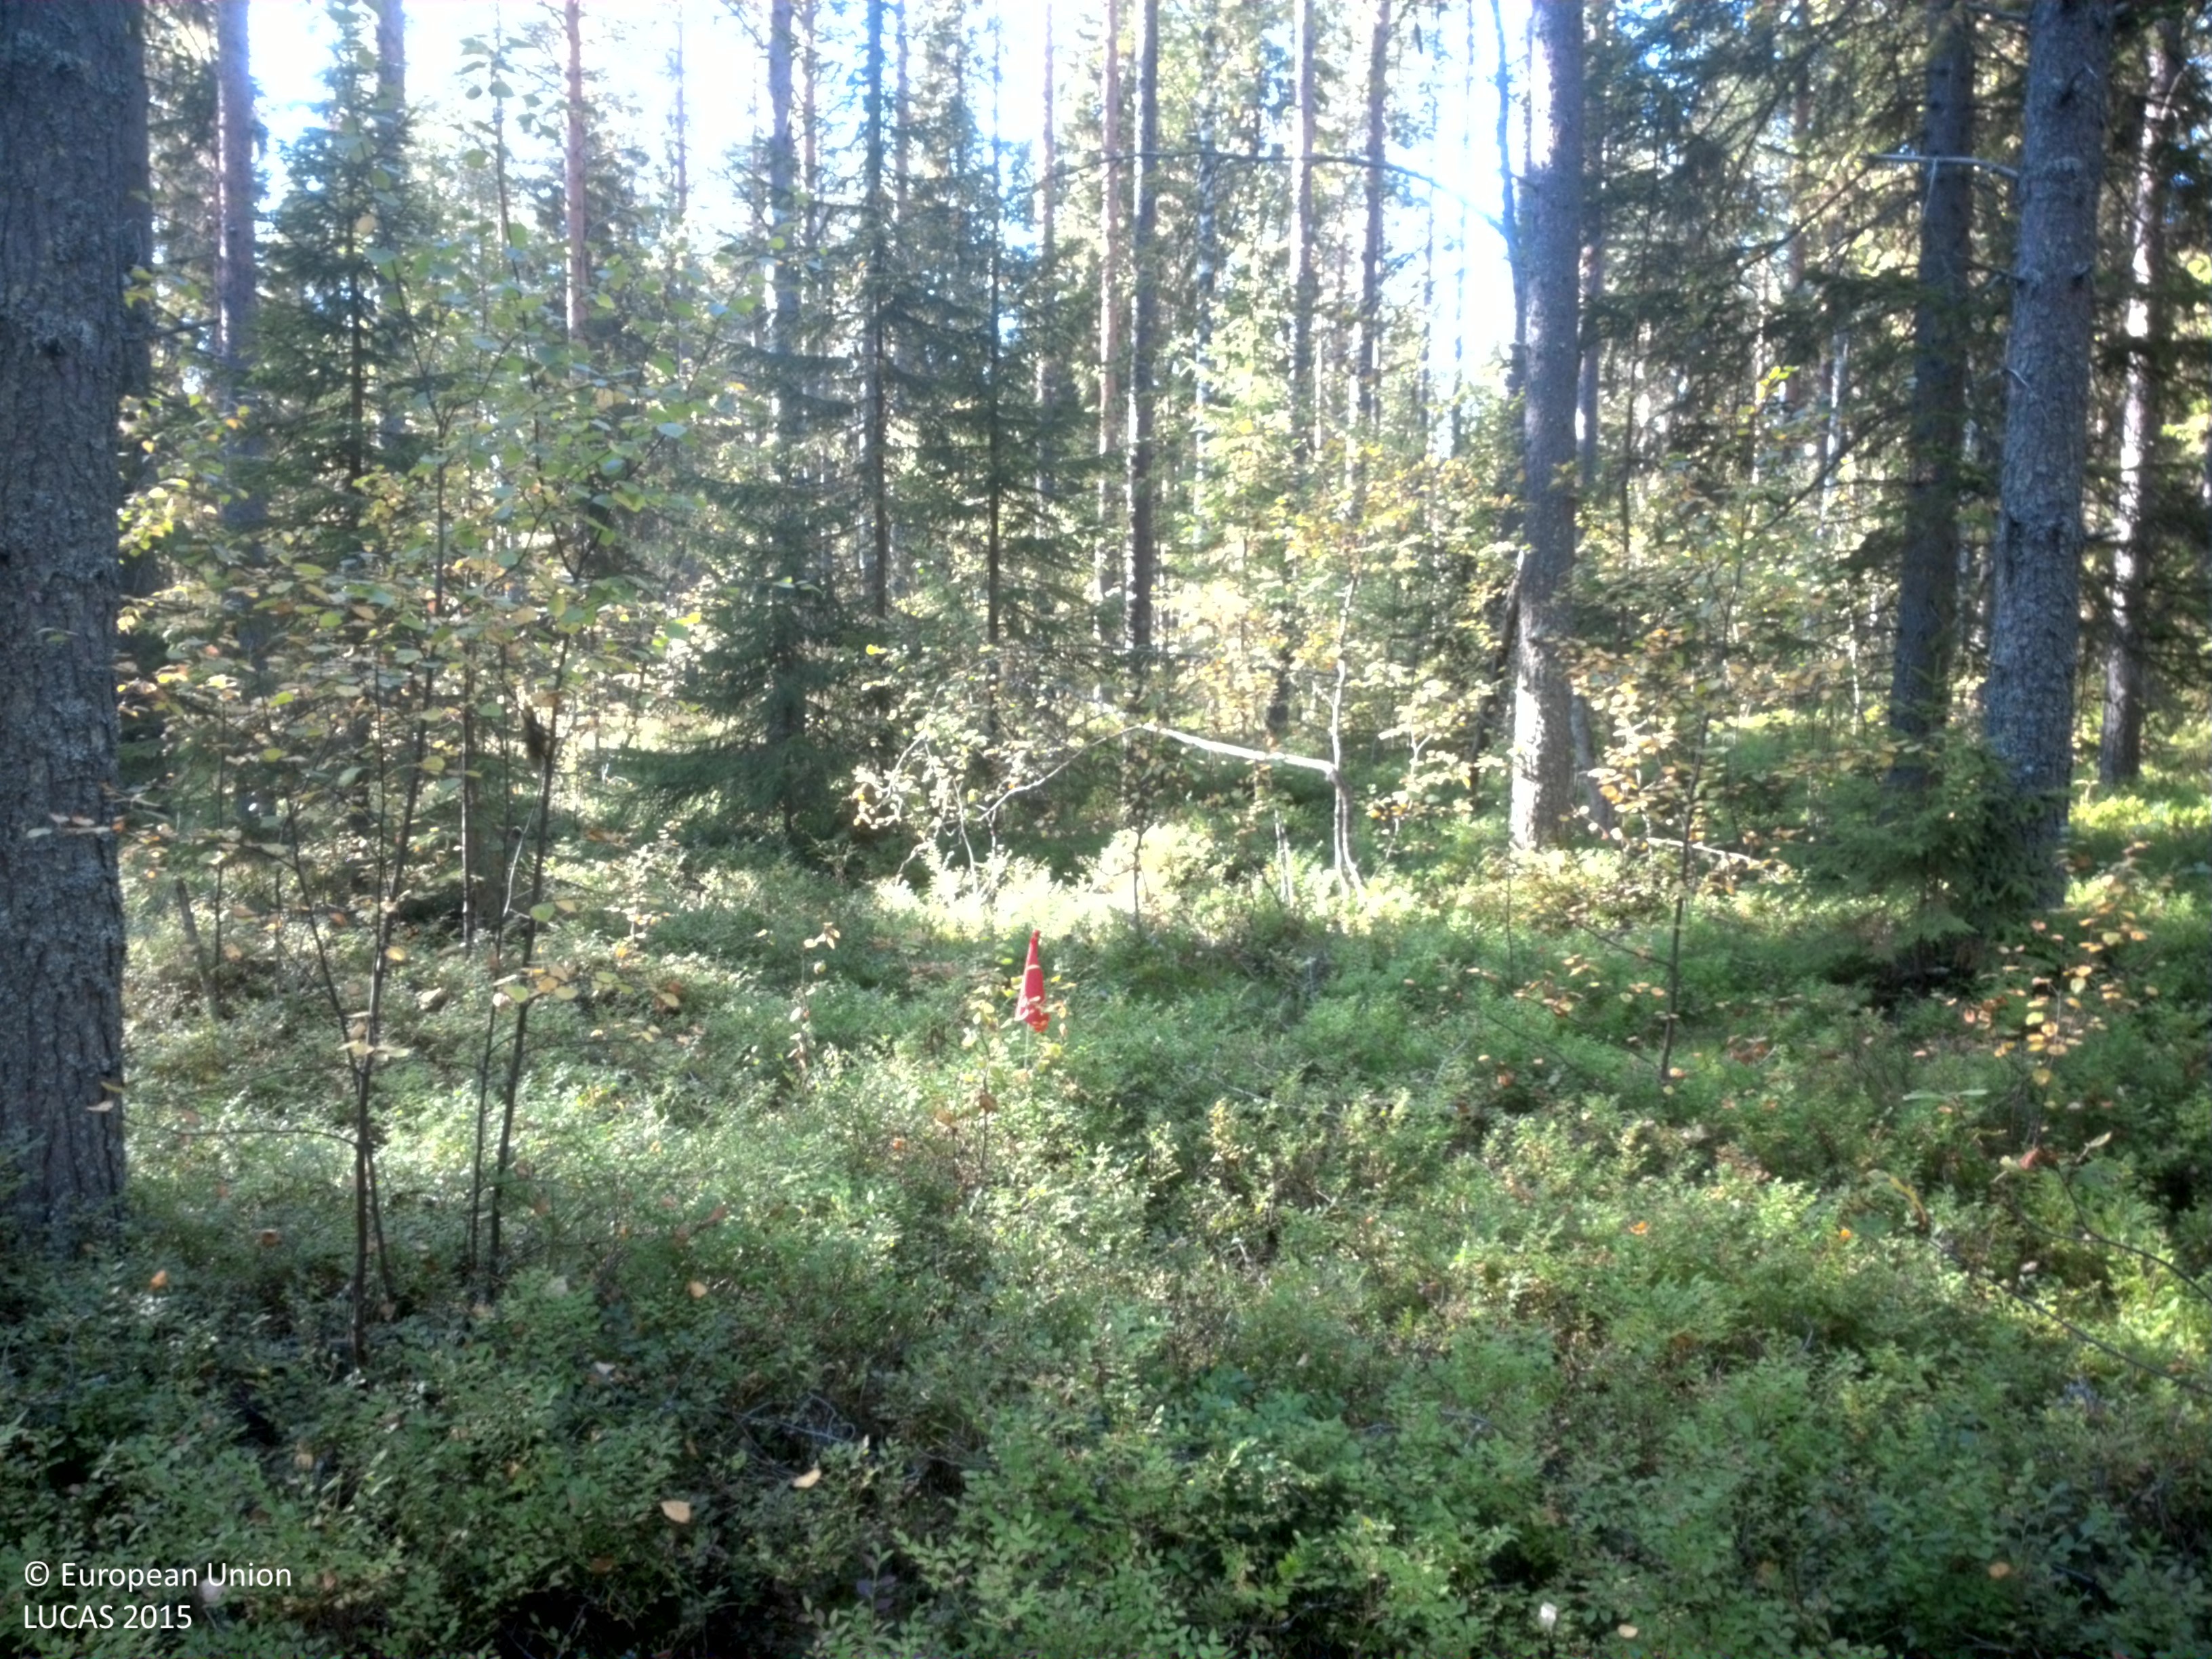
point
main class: Woodland
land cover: Other mixed woodland
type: boreal forest
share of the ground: 50 - 75 %
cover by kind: coniferous forest trees 40 %, shrubs 40 %, broadleaved forest trees 20 %
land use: Forestry
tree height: > 5 m
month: September
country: SE
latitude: 64.3184
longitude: 19.7152
